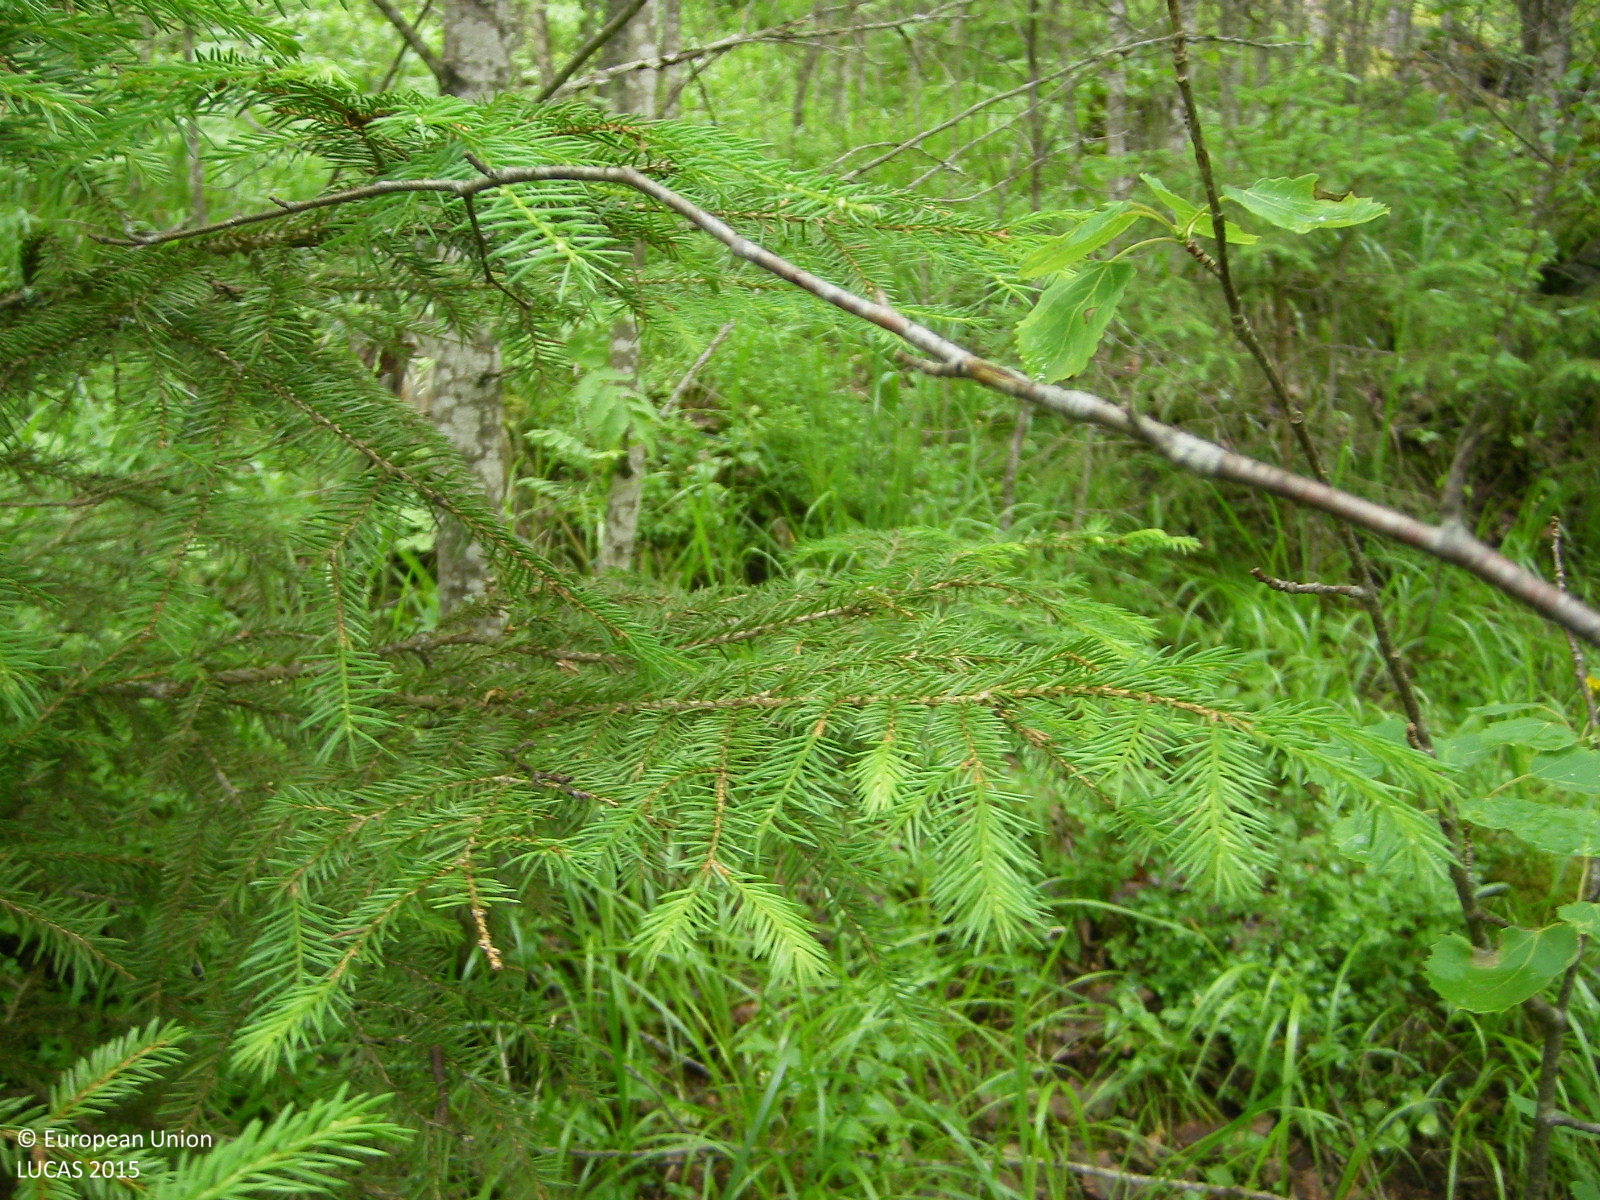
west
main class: Woodland
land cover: Broadleaved woodland
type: boreal forest
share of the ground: > 75 %
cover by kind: broadleaved forest trees 90 %, coniferous forest trees 5 %, shrubs 5 %
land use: Forestry
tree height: > 5 m
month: June
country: FI
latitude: 60.3559
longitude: 23.2604
